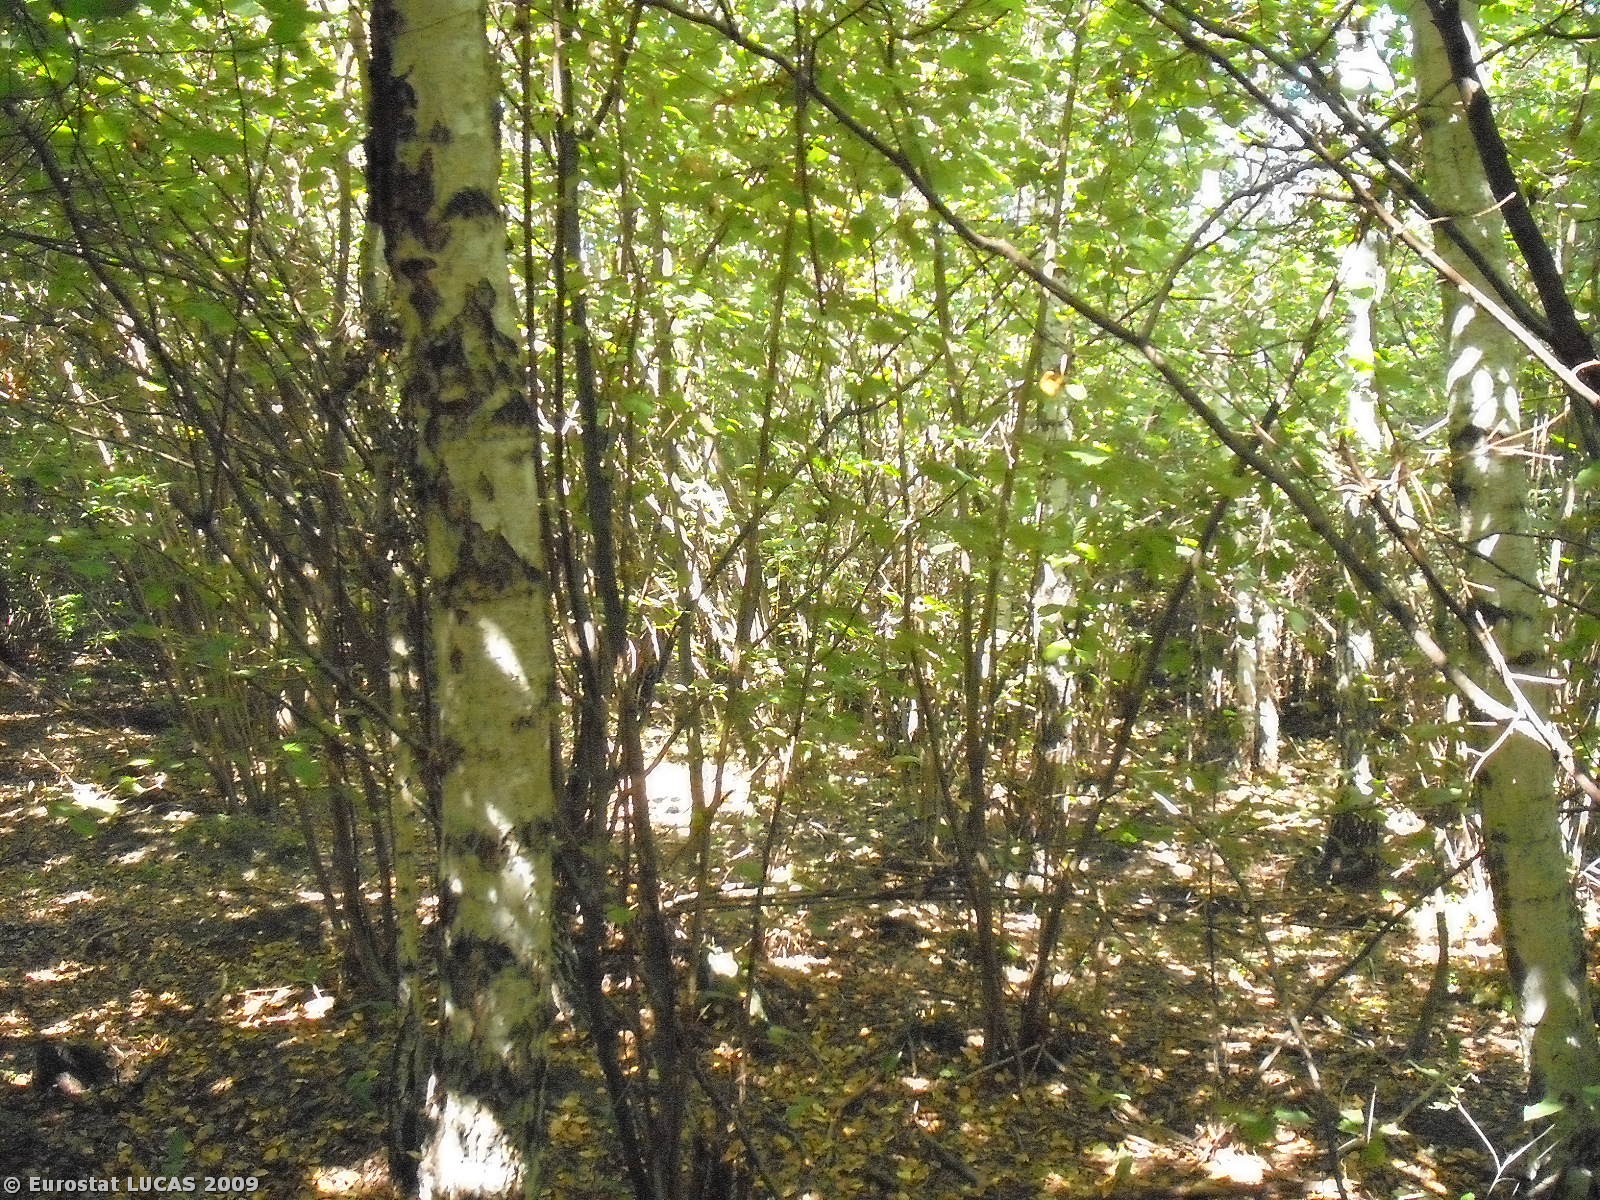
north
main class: Woodland
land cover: Broadleaved woodland
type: mesophytic deciduous forest
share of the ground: > 75 %
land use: Forestry
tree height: > 5 m
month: September
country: PL
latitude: 50.5023
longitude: 20.6279
